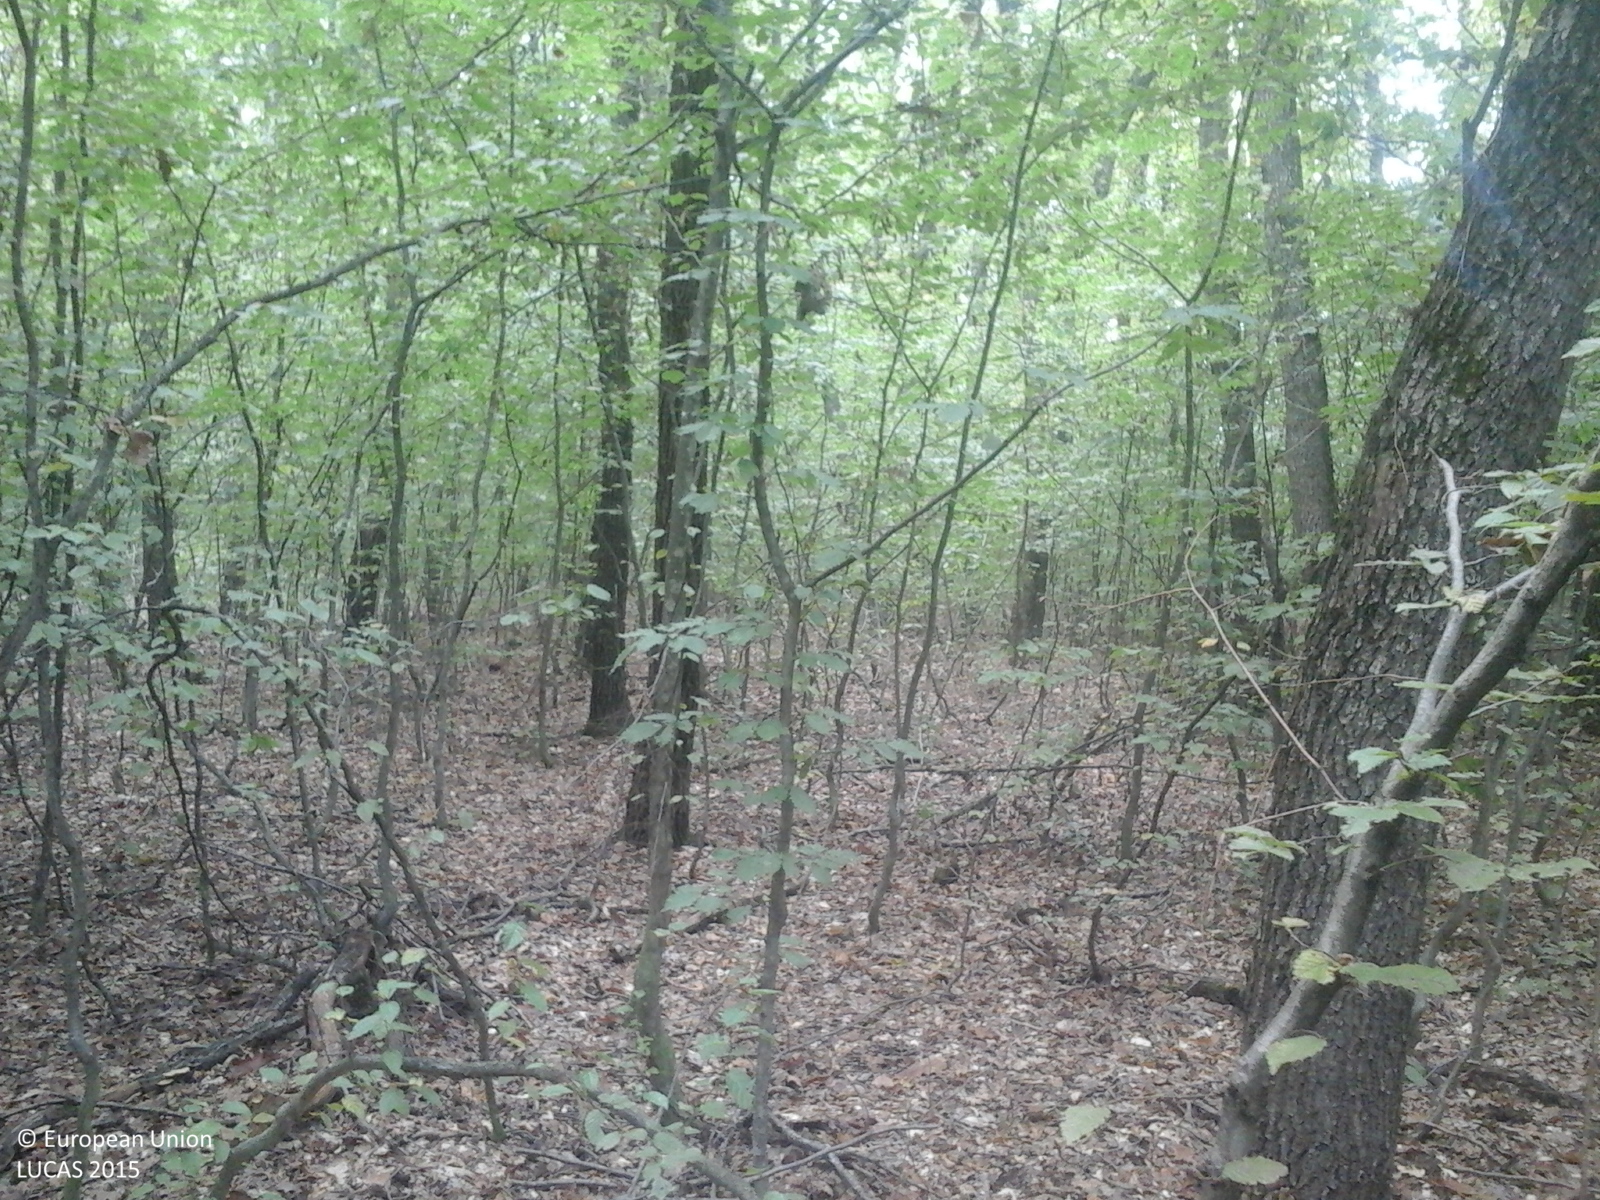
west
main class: Woodland
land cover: Broadleaved woodland
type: acidophilous oak and oak-birch forest
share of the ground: > 75 %
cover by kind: broadleaved forest trees 100 %
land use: Forestry
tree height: > 5 m
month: October
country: RO
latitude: 46.3301
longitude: 23.6436
